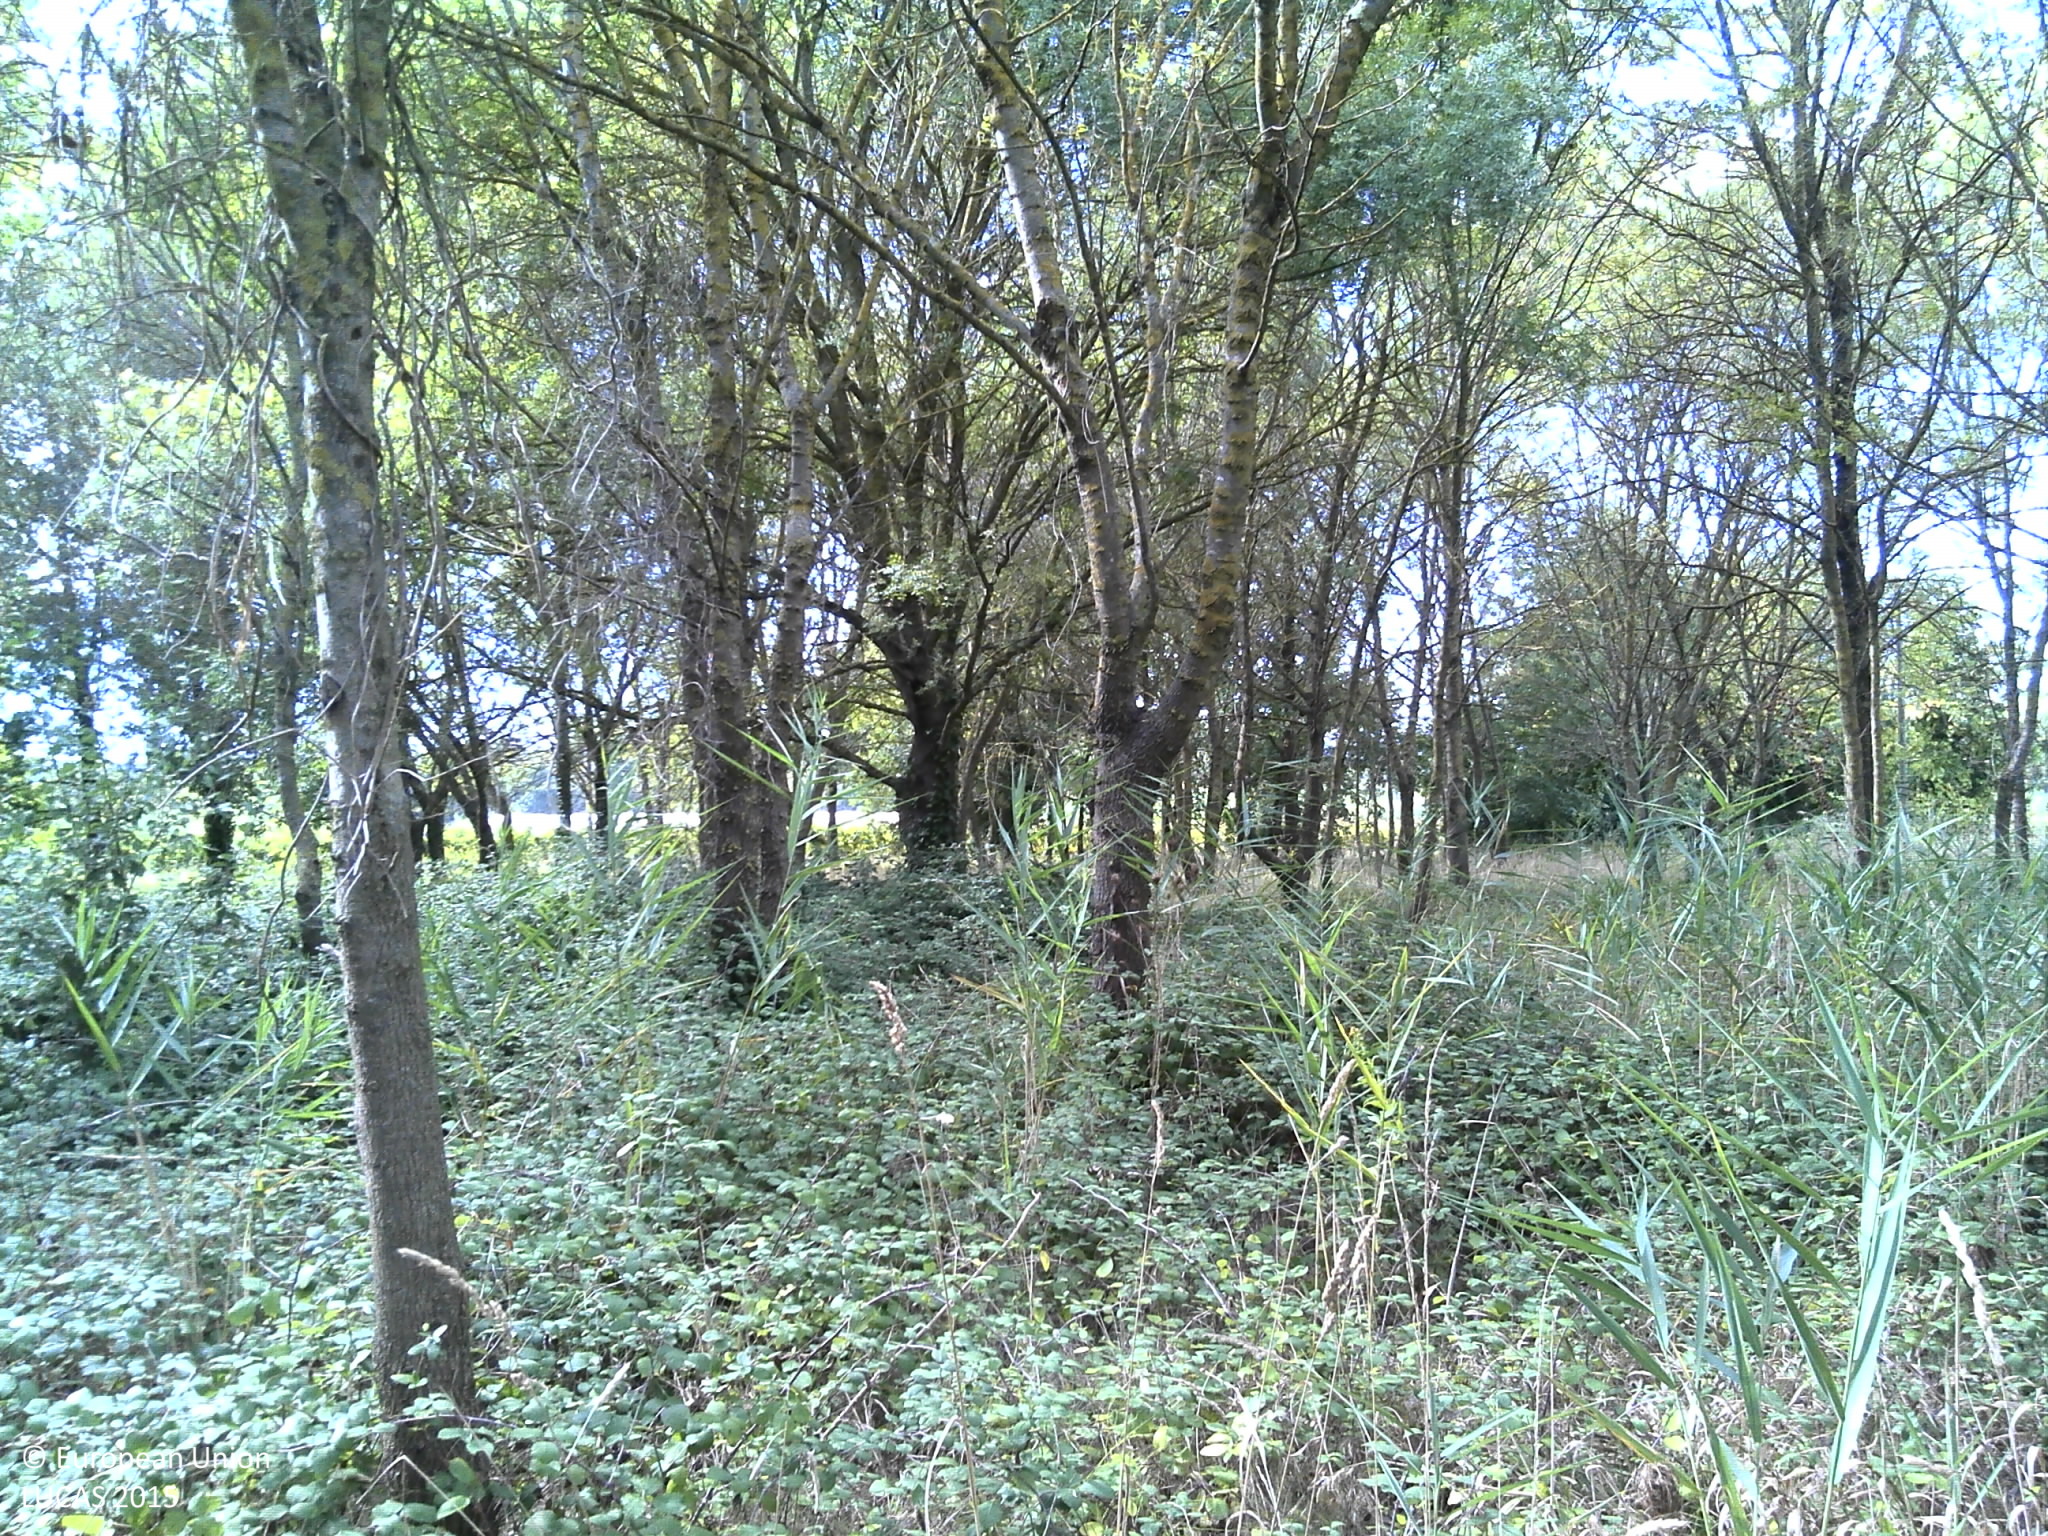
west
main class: Woodland
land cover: Broadleaved woodland
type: thermophilous deciduous forest
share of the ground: > 75 %
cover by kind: broadleaved forest trees 70 %, herbaceous plants 20 %, unconsolidated bare surface 10 %
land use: Abandoned areas
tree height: > 5 m
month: October
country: FR
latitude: 43.2646
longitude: 6.5717
